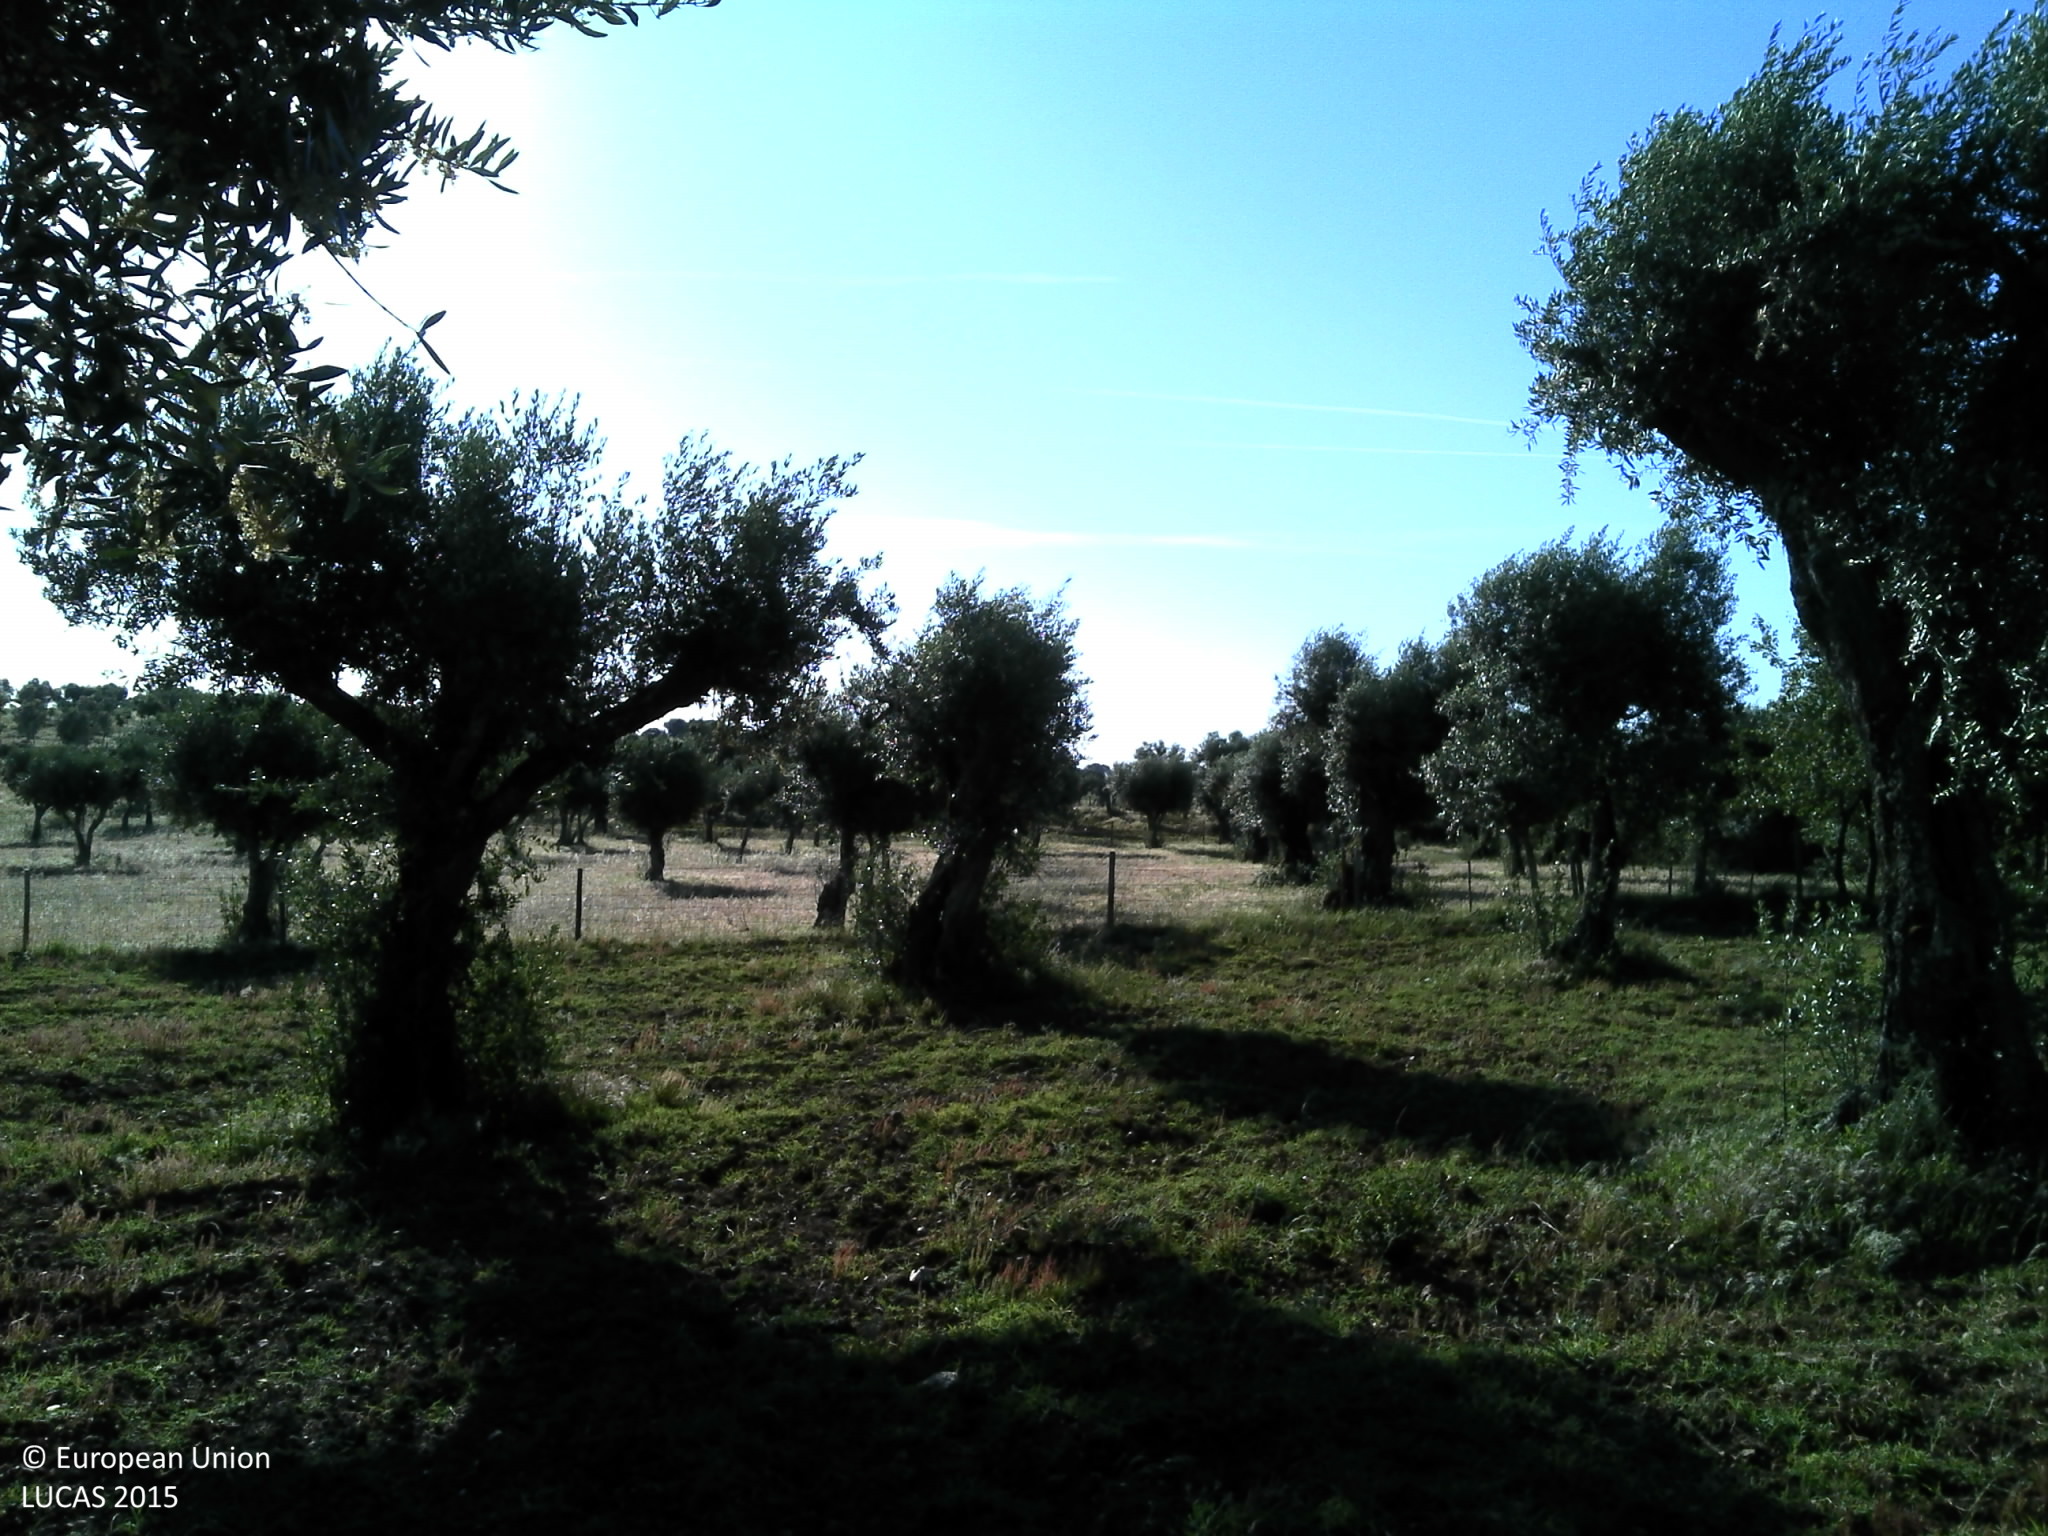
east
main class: Cropland
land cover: Olive groves
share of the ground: 10 - 25 %
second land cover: Grassland without tree/shrub cover
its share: 10 - 25 %
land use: Agriculture (excluding fallow land and kitchen gardens)
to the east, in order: Olive groves; Grassland without tree/shrub cover; Olive groves; Fences; Olive groves; Fences; Olive groves; Fences; Tracks; Fences; Olive groves; Fences; Grass margins; Fences; Olive groves
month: May
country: PT
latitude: 39.1638
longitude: -7.9797
